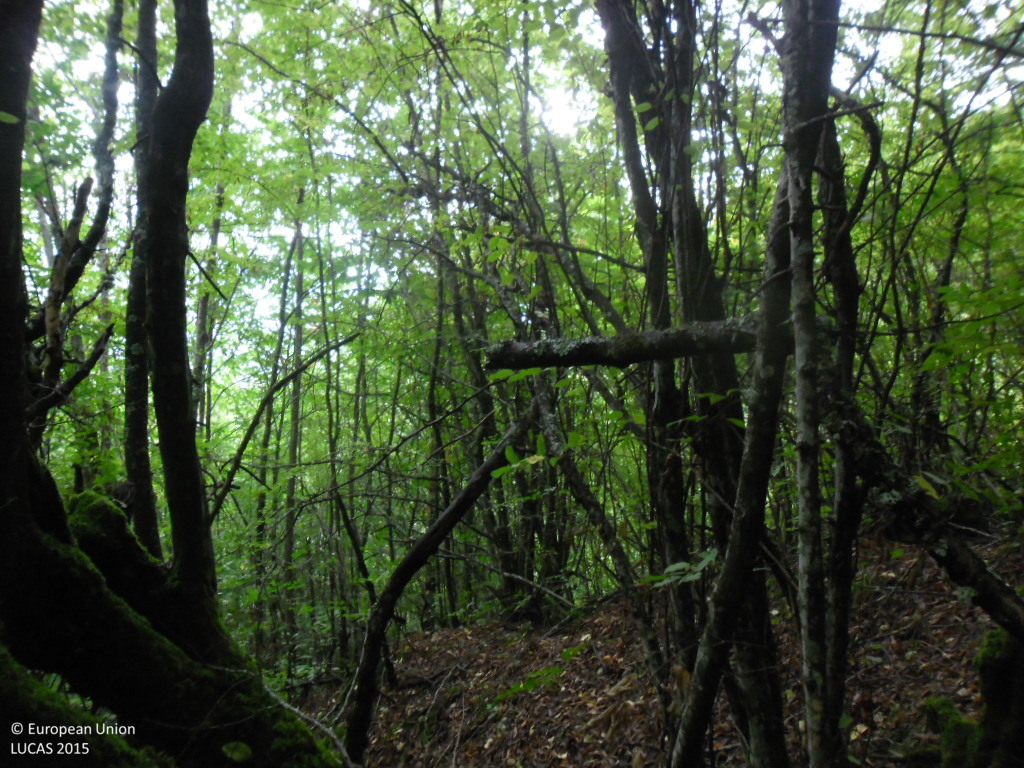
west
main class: Woodland
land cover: Broadleaved woodland
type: mesophytic deciduous forest
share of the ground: > 75 %
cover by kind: broadleaved forest trees 90 %, unconsolidated bare surface 10 %
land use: Forestry
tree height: > 5 m
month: September
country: BG
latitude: 41.3574
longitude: 22.9851
